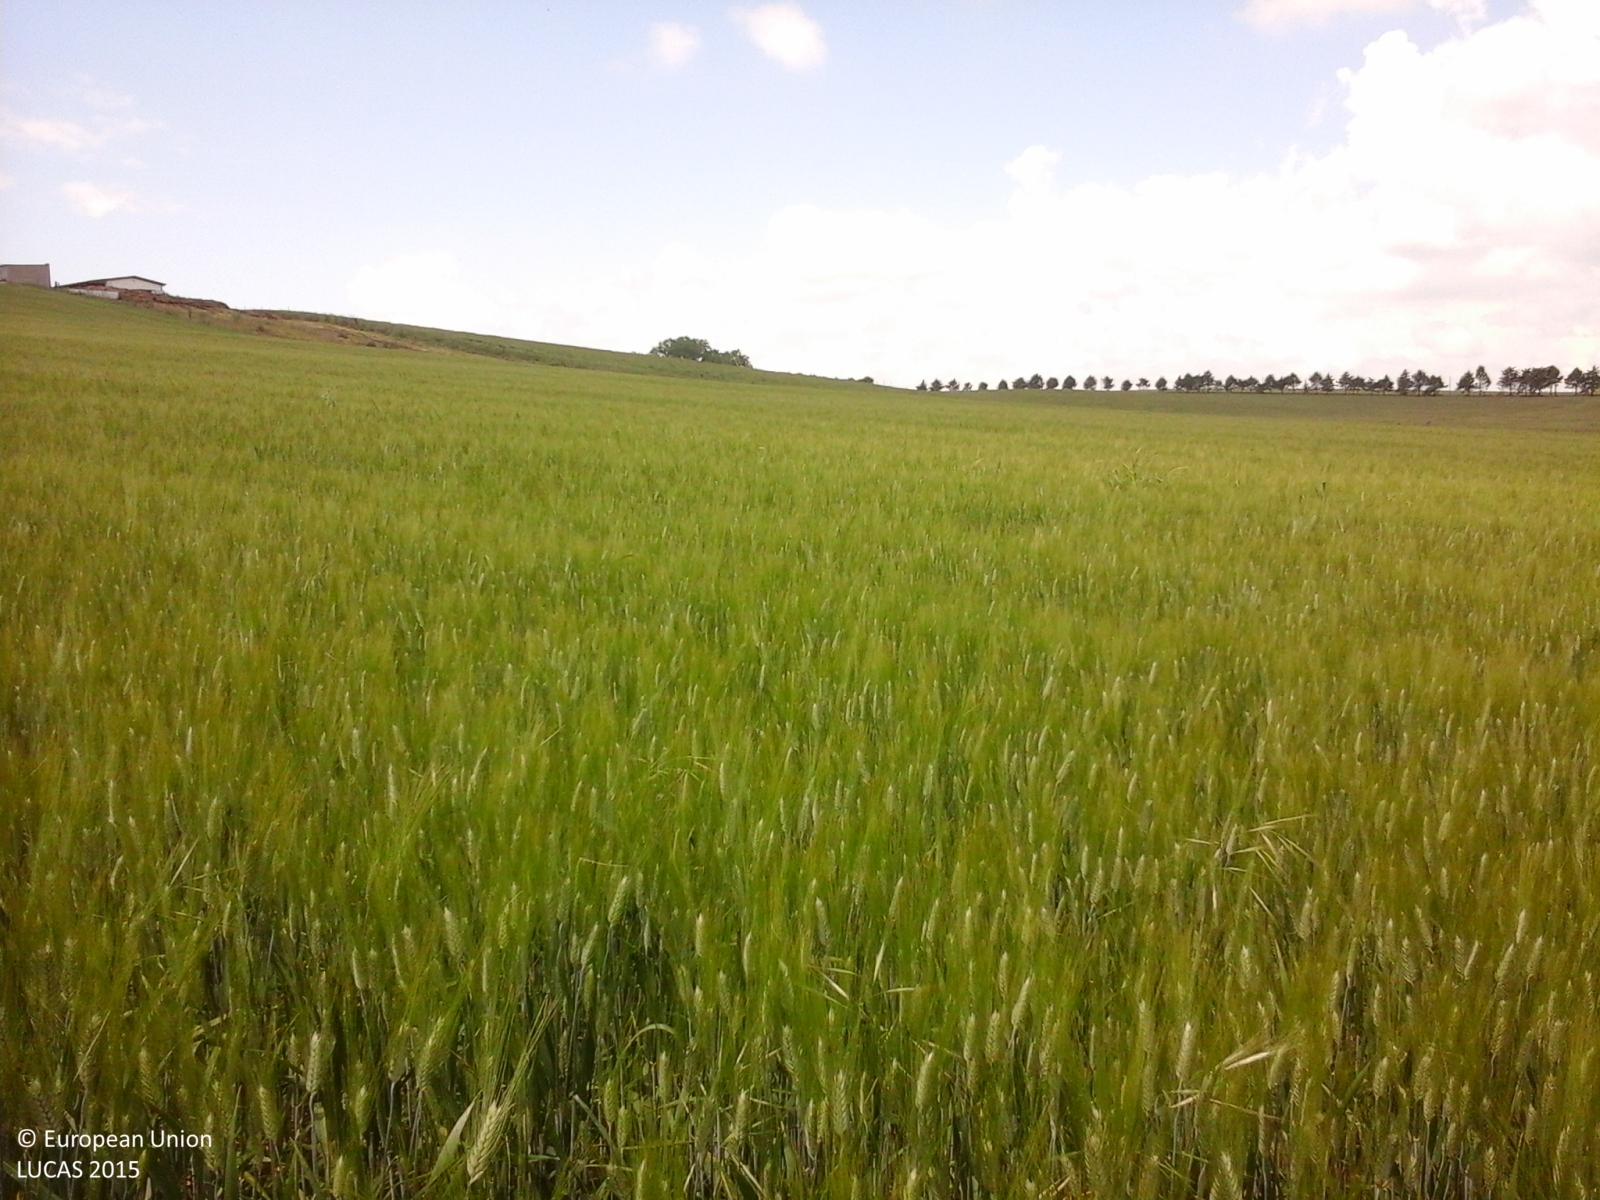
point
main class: Cropland
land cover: Durum wheat
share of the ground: > 75 %
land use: Agriculture (excluding fallow land and kitchen gardens)
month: May
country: IT
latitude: 41.2390
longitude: 15.1242
